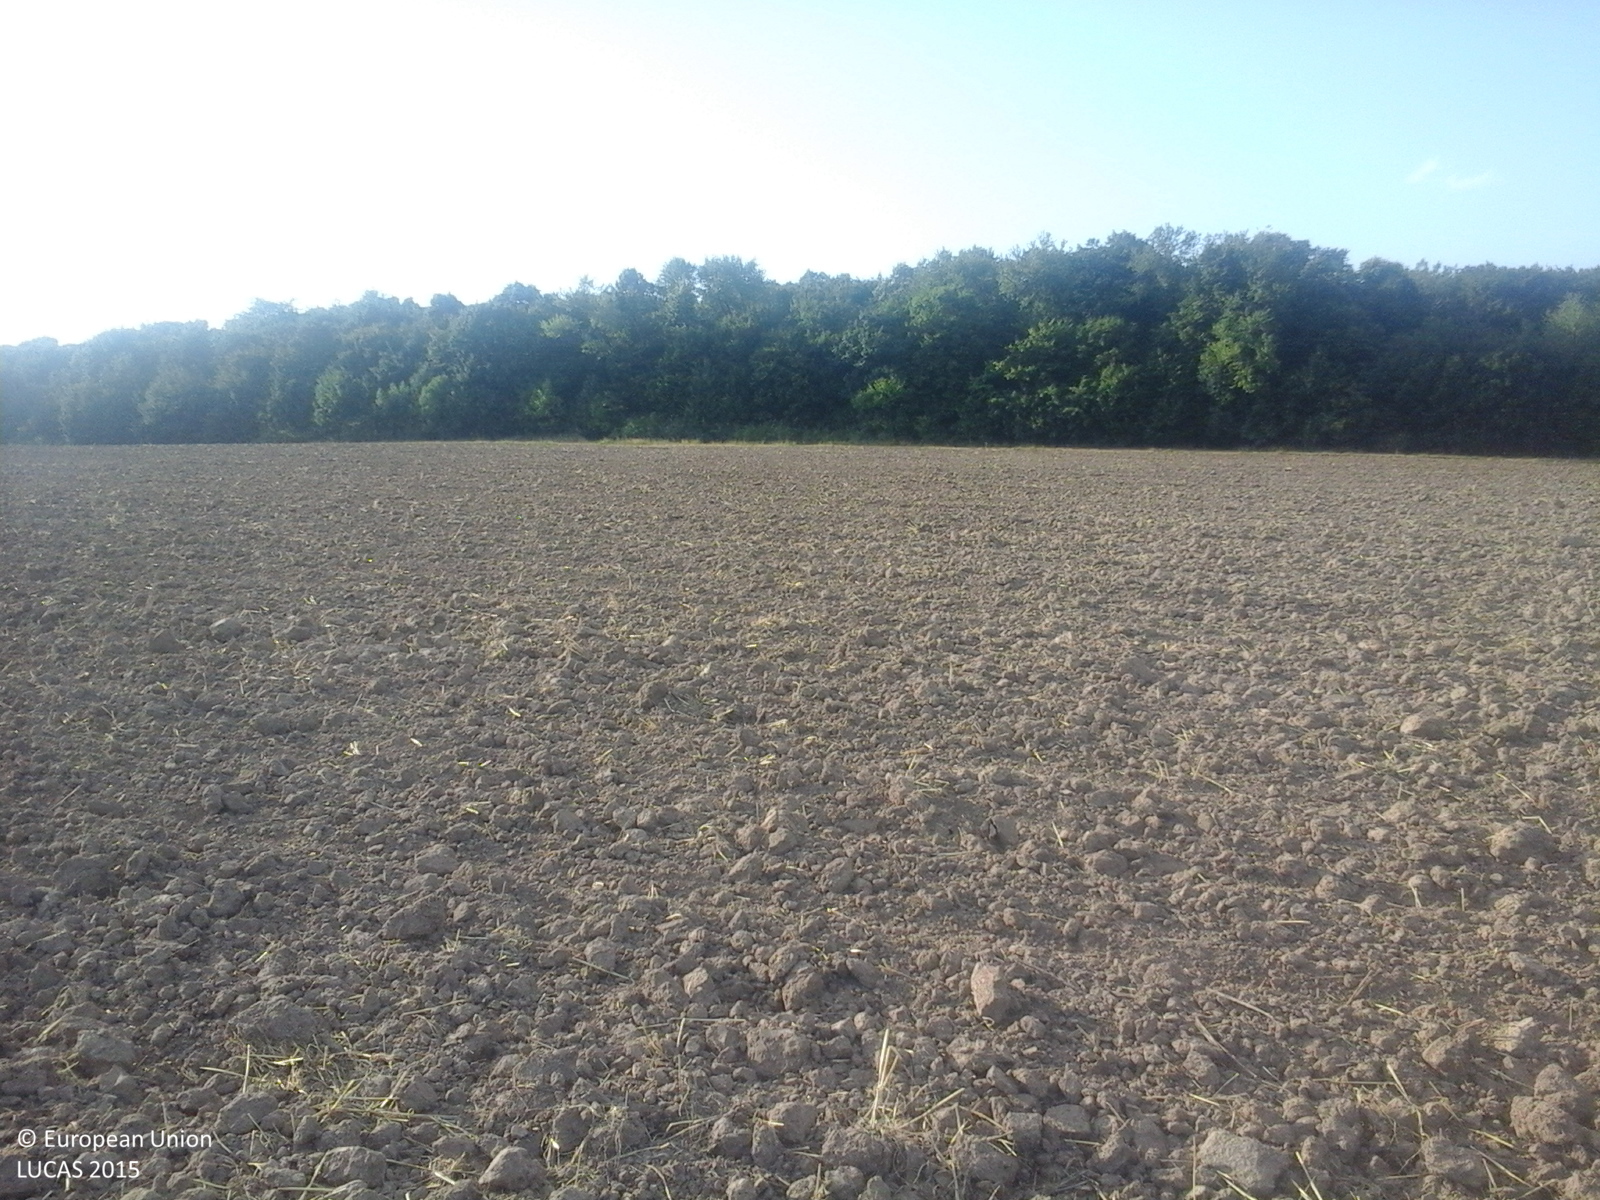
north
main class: Cropland
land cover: Durum wheat
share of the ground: < 10 %
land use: Agriculture (excluding fallow land and kitchen gardens)
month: July
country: RO
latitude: 46.5400
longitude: 27.8967
